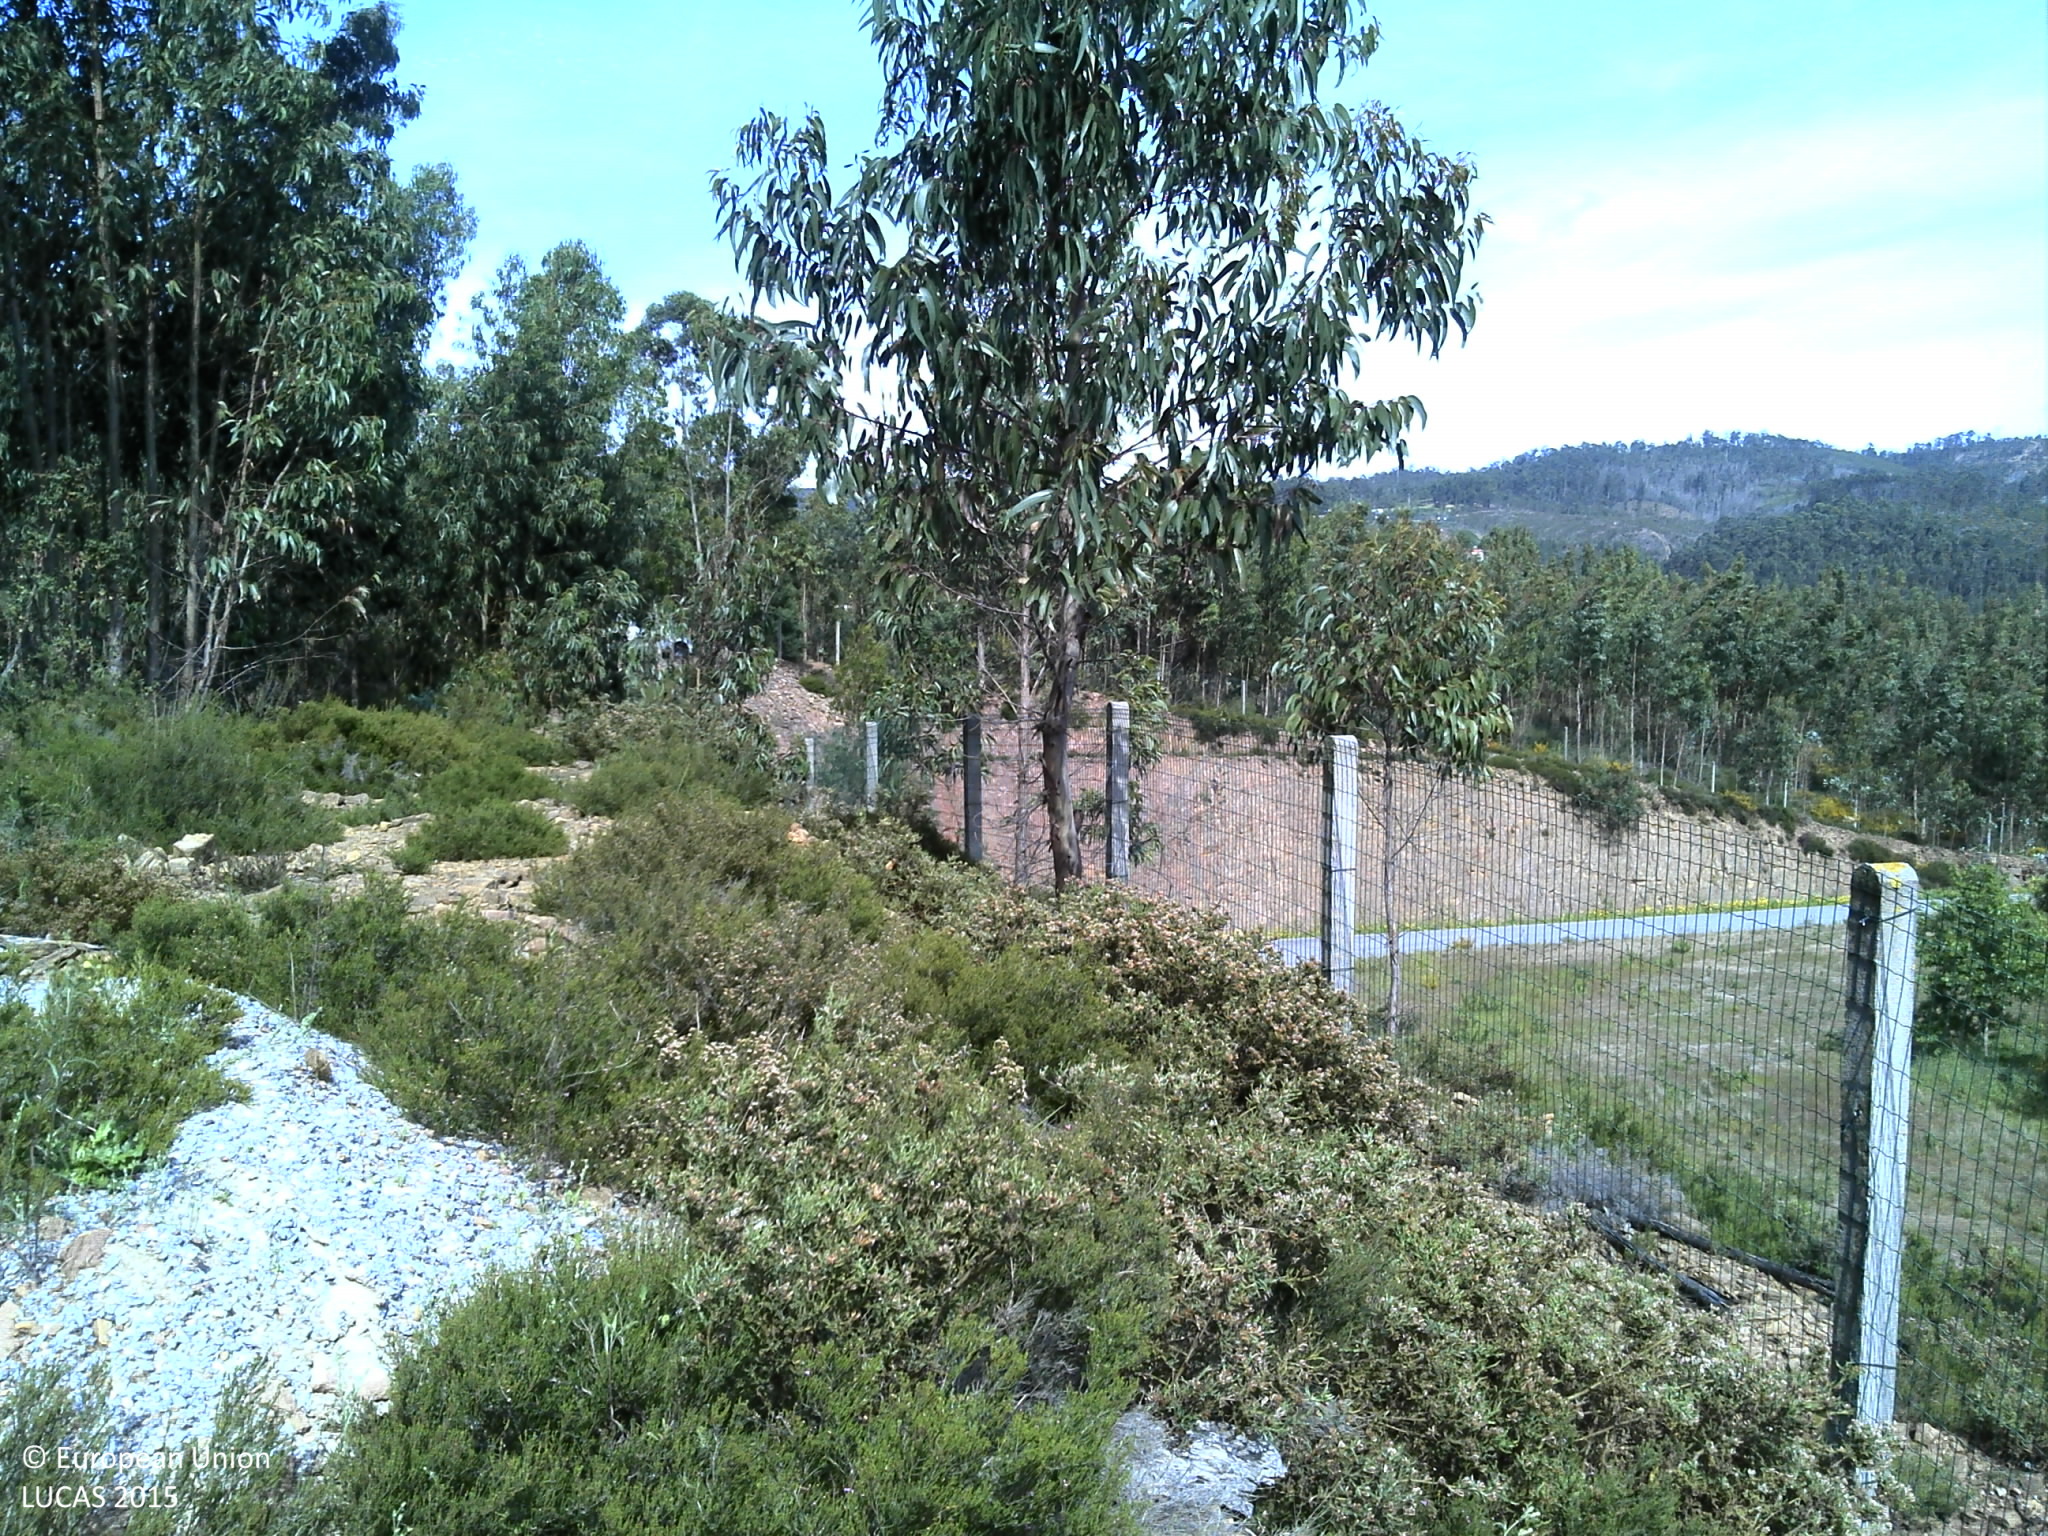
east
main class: Shrubland
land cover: Shrubland with sparse tree cover
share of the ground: 50 - 75 %
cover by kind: shrubs 65 %, consolidated bare surface 15 %, unconsolidated bare surface 10 %, broadleaved forest trees 5 %, herbaceous plants 5 %
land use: Forestry
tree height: > 5 m
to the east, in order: Shrubland with sparse tree cover; Single bushes/trees; Fences; Shrubland with sparse tree cover; Paved roads, cycling and walking lanes; Grassland without tree/shrub cover; Paved roads, cycling and walking lanes; Rock outcrops; Single bushes/trees; Fences; Broadleaved woodland; Shrubland without tree cover; Shrubland with sparse tree cover
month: May
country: PT
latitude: 41.2696
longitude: -8.4743
